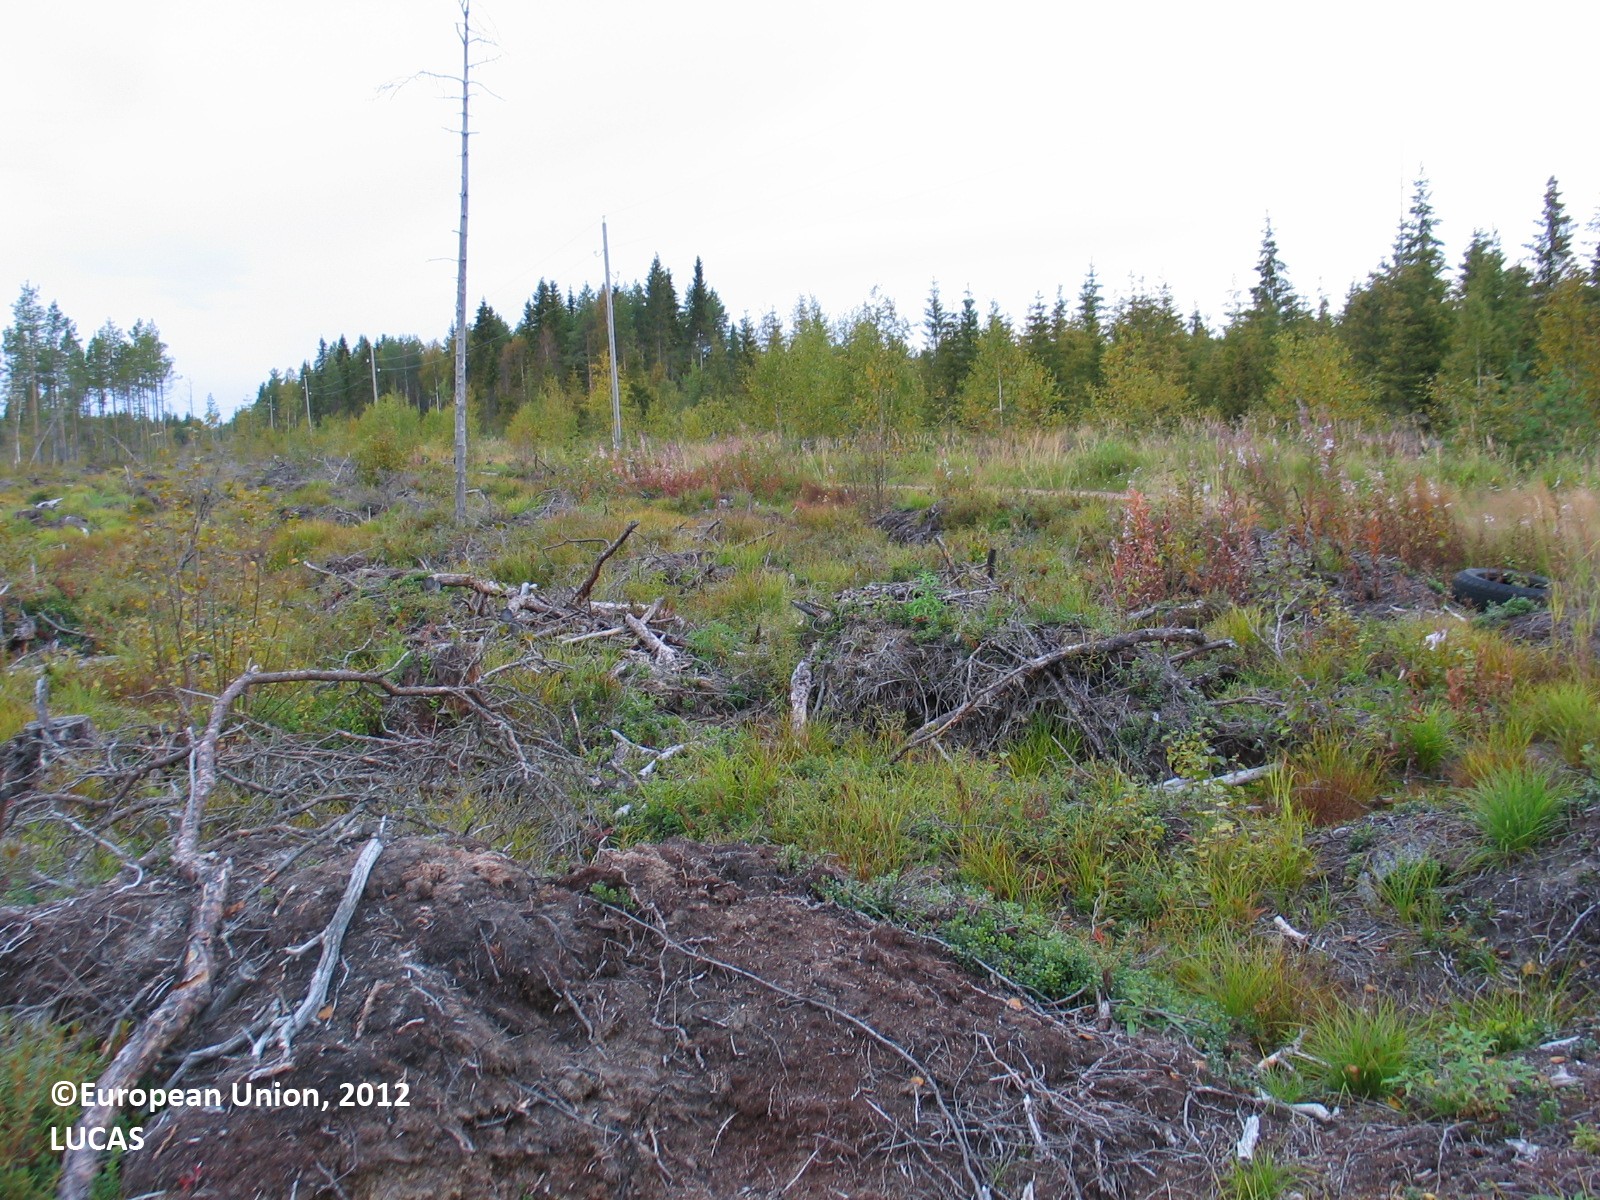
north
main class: Shrubland
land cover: Shrubland with sparse tree cover
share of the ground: 50 - 75 %
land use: Forestry
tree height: < 5 m
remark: Clear cut
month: September
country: FI
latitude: 65.3123
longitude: 25.5079
